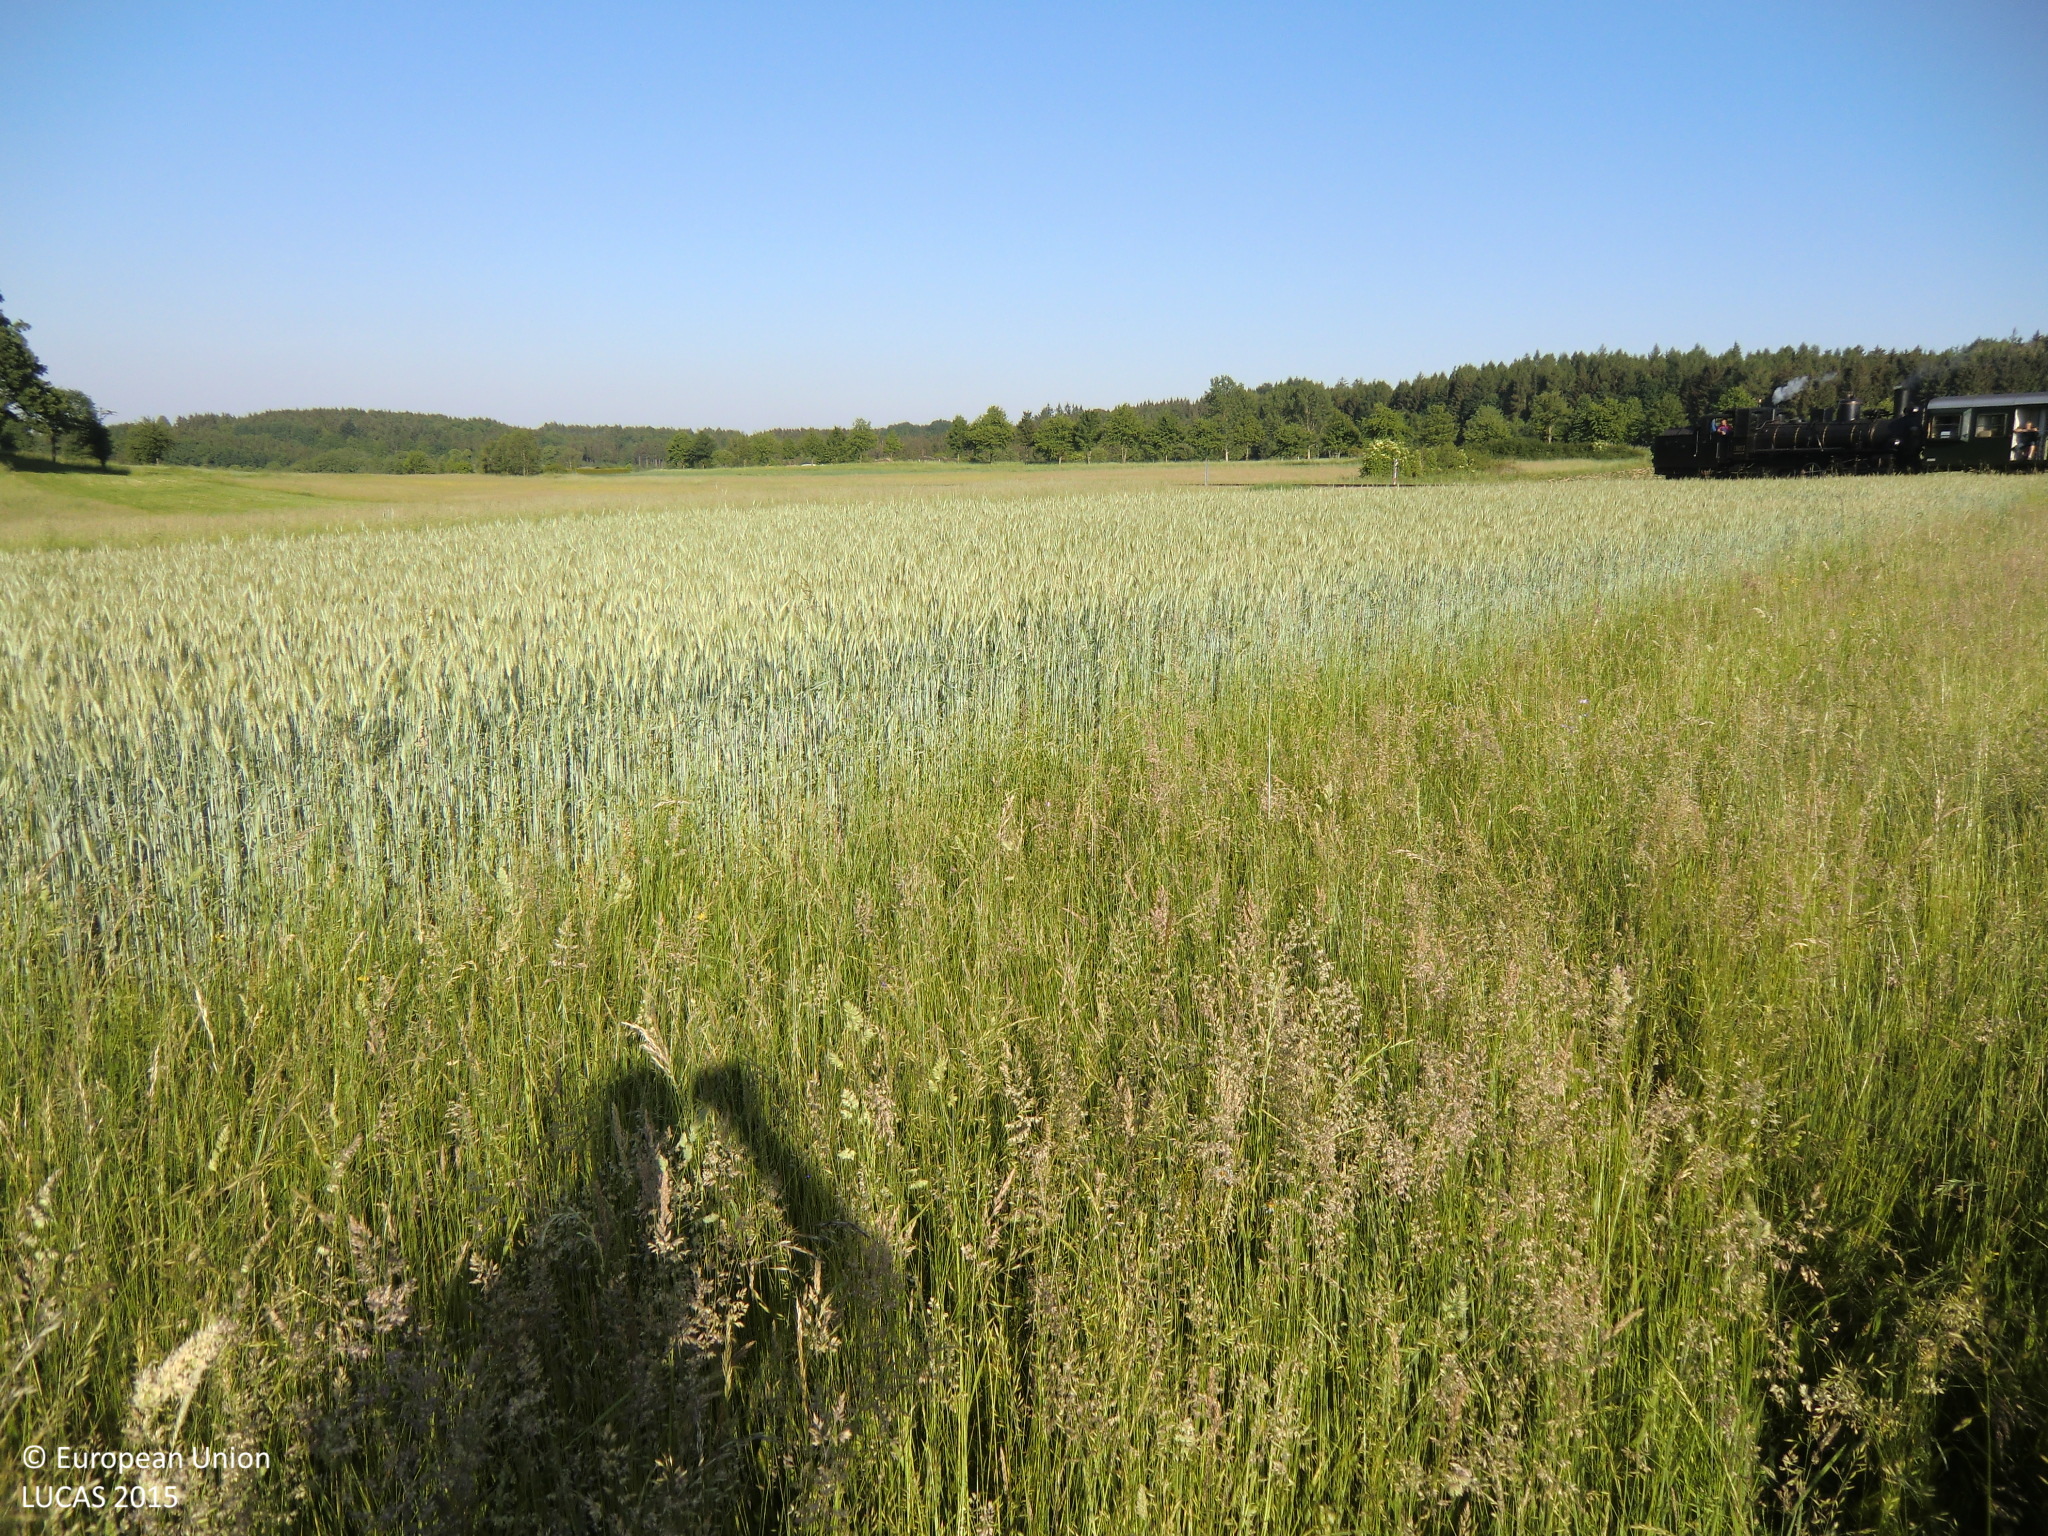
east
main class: Grassland
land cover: Grassland without tree/shrub cover
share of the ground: > 75 %
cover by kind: herbaceous plants 100 %
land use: Agriculture (excluding fallow land and kitchen gardens)
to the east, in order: Grassland without tree/shrub cover; Triticale; Potatoes; Grassland without tree/shrub cover
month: June
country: AT
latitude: 48.6924
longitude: 14.8787
